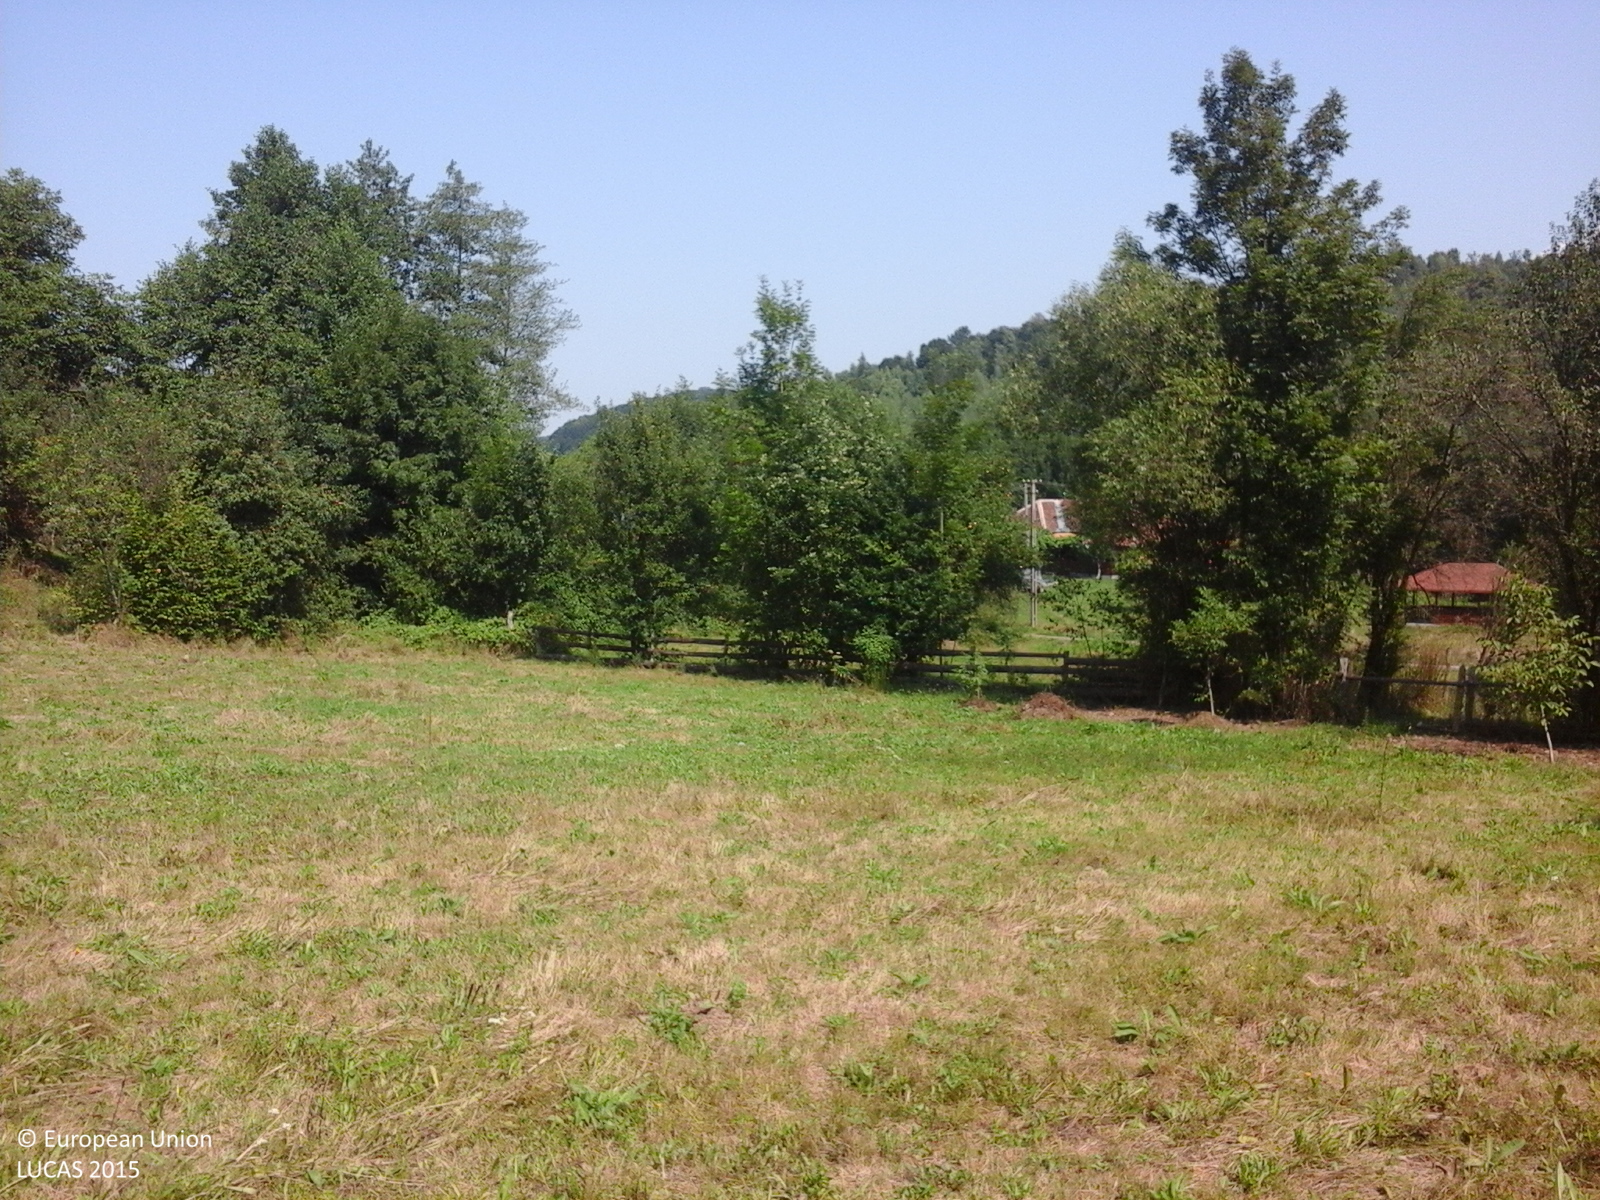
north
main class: Grassland
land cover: Grassland without tree/shrub cover
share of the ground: > 75 %
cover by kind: herbaceous plants 100 %
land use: Agriculture (excluding fallow land and kitchen gardens)
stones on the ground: < 10 %
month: August
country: RO
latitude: 46.3420
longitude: 22.5107
